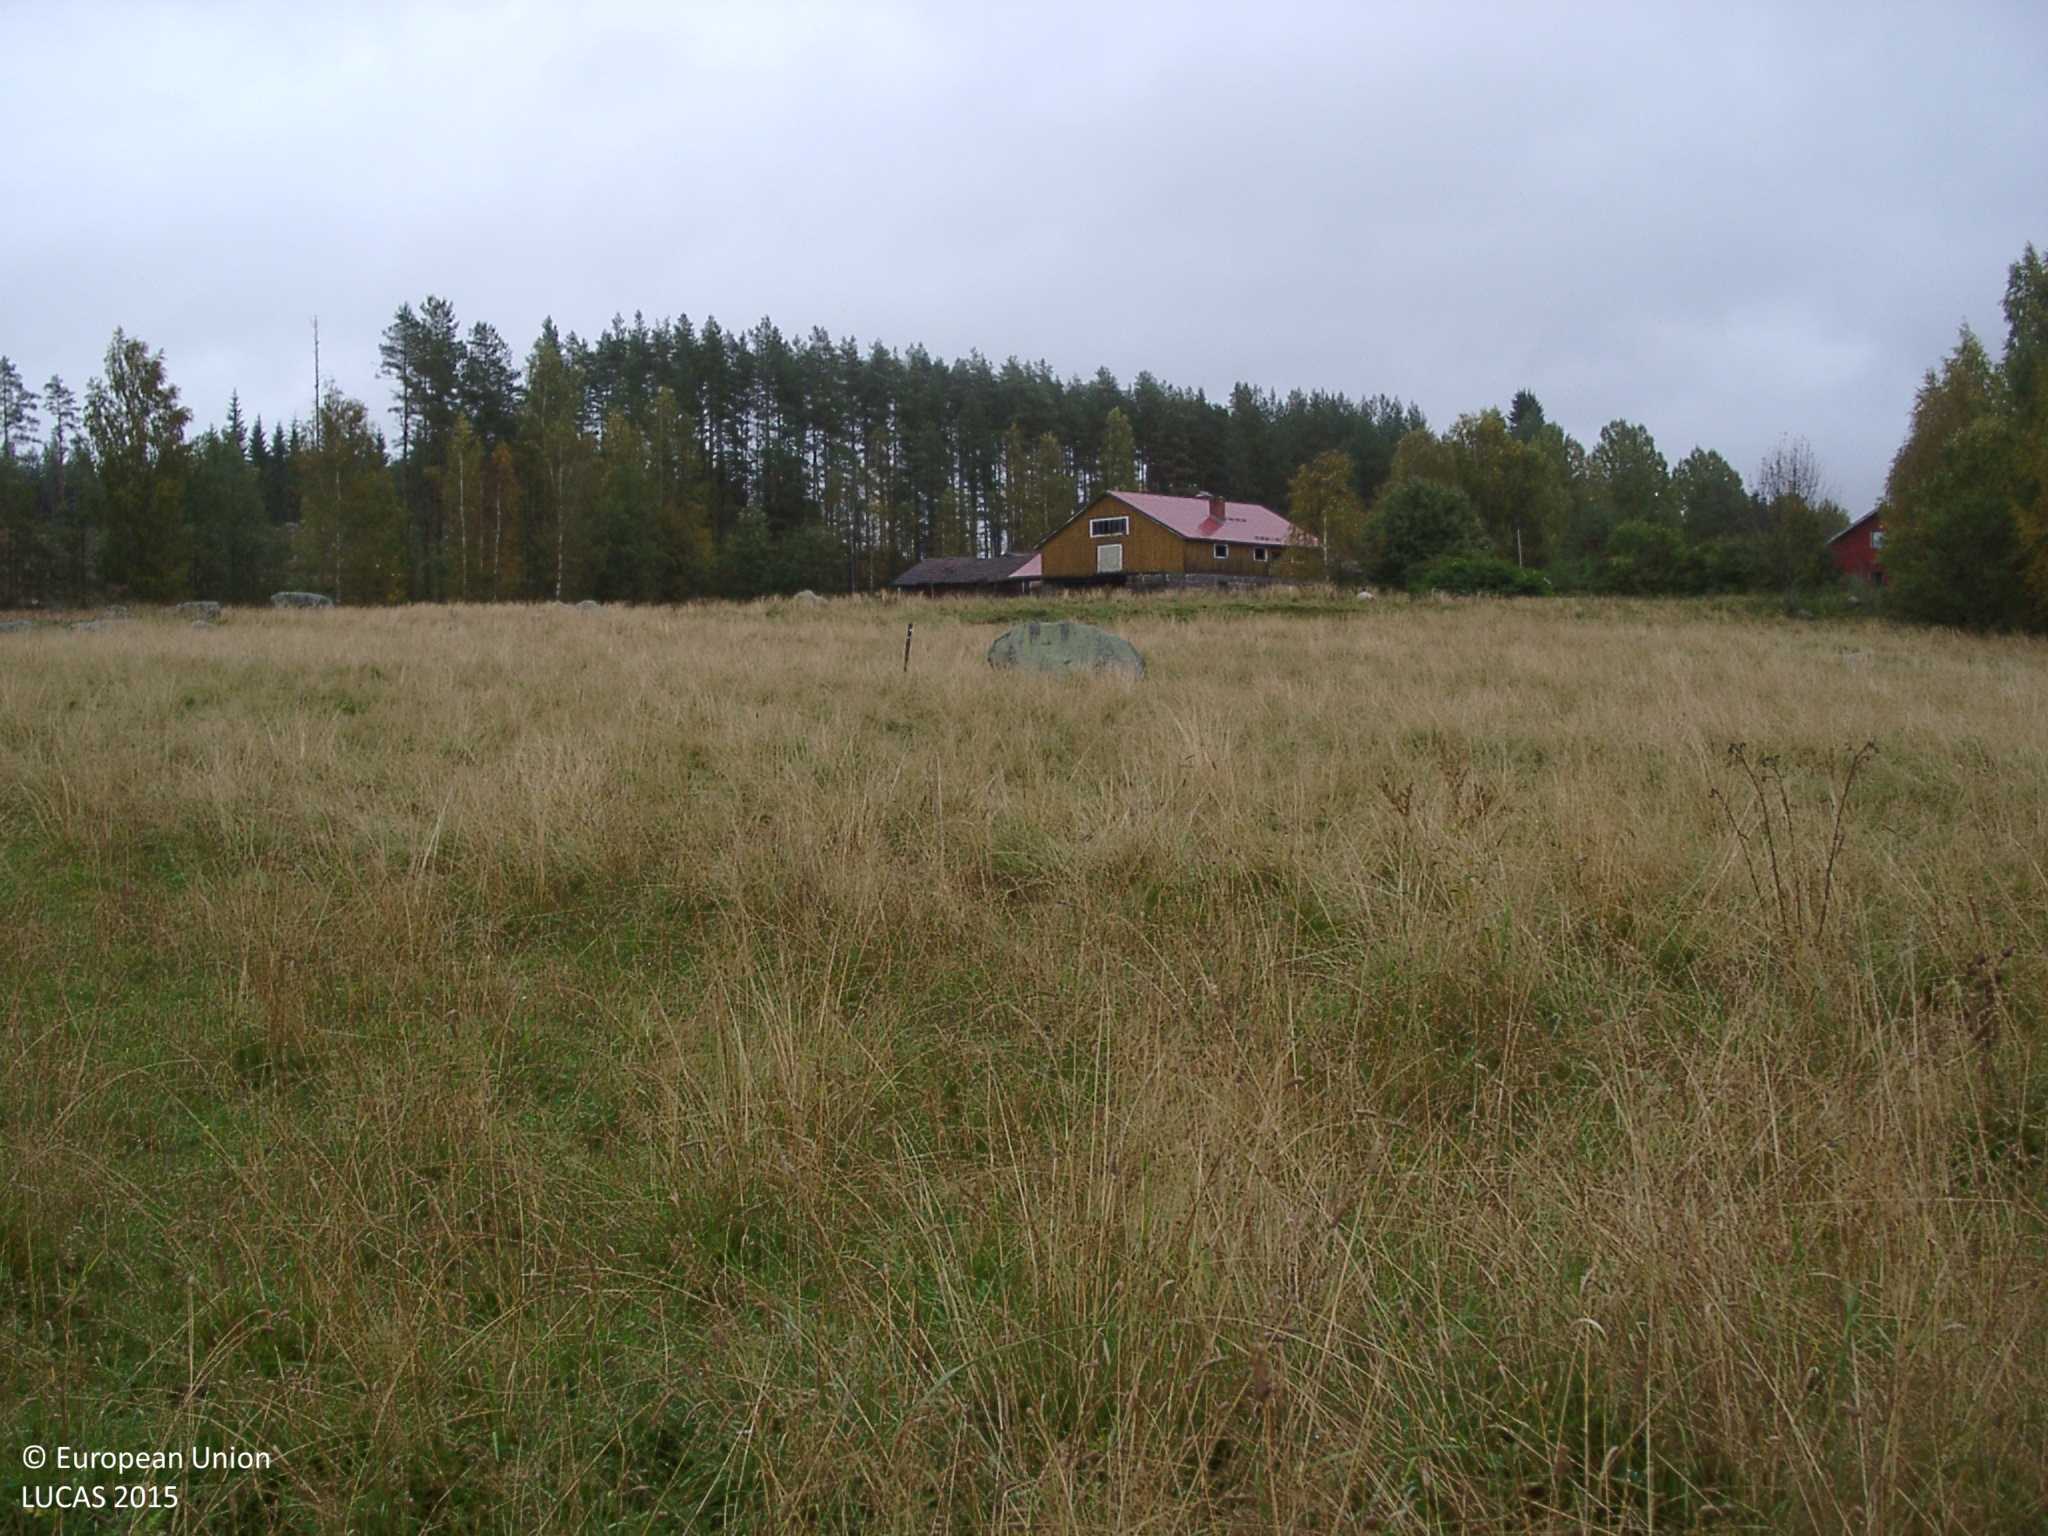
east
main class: Grassland
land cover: Grassland without tree/shrub cover
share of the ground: > 75 %
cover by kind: herbaceous plants 100 %
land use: Agriculture (excluding fallow land and kitchen gardens)
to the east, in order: Grassland without tree/shrub cover; Ditches and canals; Grassland without tree/shrub cover; Ditches and canals; Grassland without tree/shrub cover; Ditches and canals; Grassland without tree/shrub cover; Fences; Grassland without tree/shrub cover; Ditches and canals; Fences; Groves; Tracks; Grass margins; Ditches and canals; Broadleaved woodland; Pine dominated mixed woodland; Pine dominated coniferous woodland; Lichens and moss
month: September
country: FI
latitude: 62.7595
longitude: 25.5214
